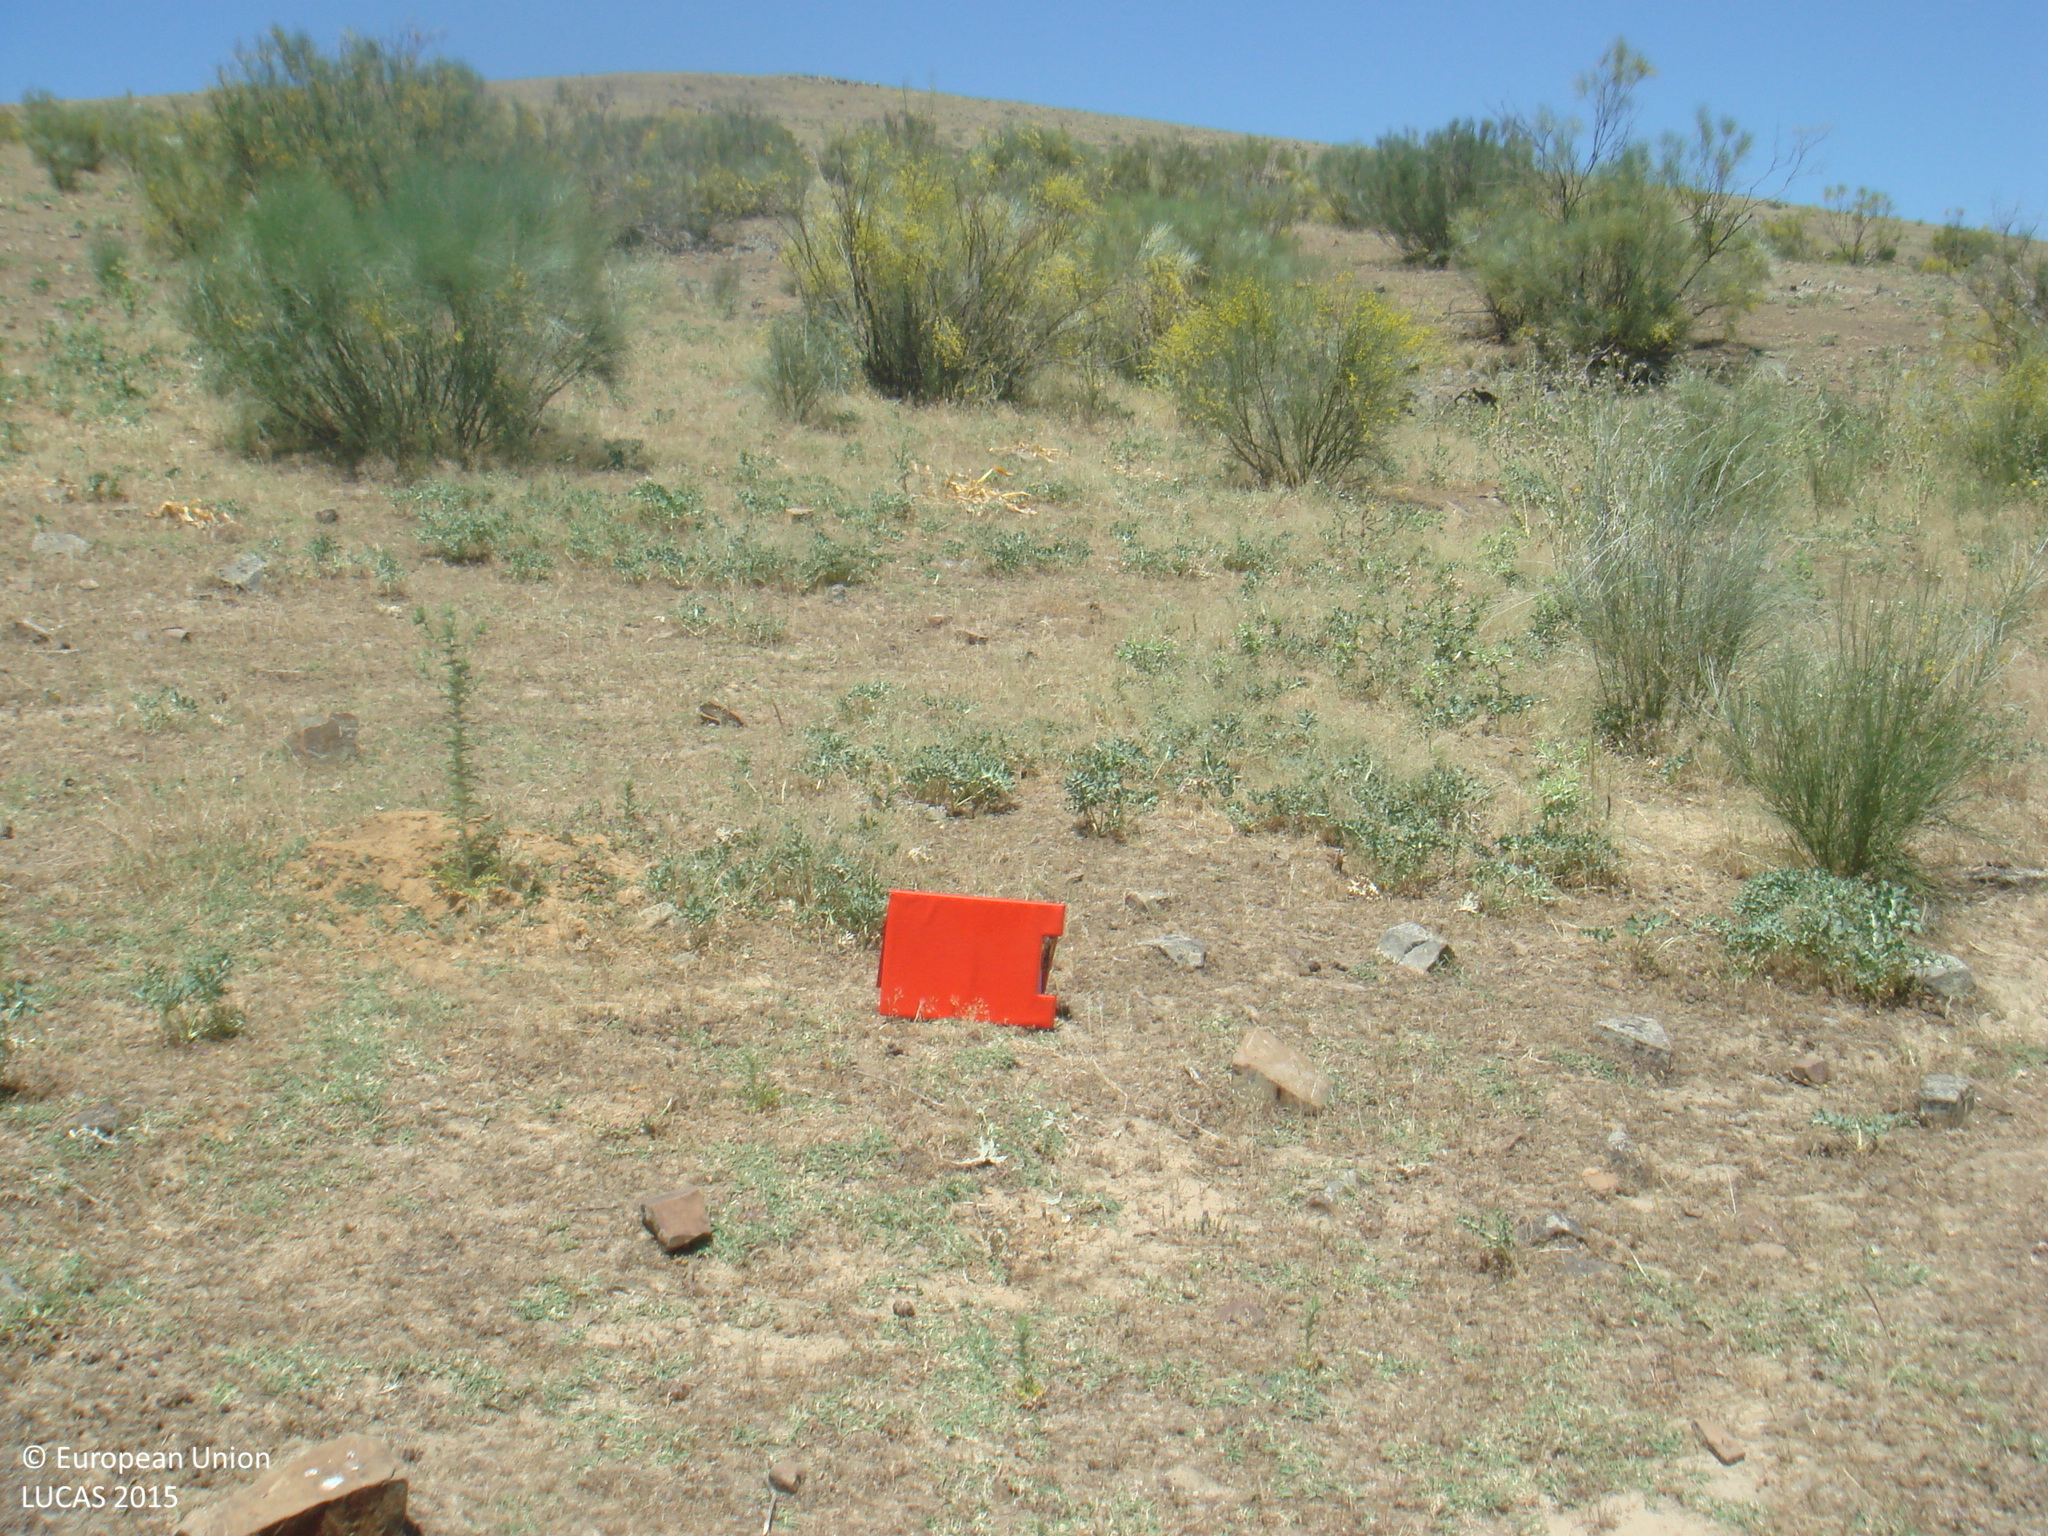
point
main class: Shrubland
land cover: Shrubland without tree cover
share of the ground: 10 - 25 %
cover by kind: herbaceous plants 75 %, shrubs 20 %
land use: Agriculture (excluding fallow land and kitchen gardens)
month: May
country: ES
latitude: 38.7039
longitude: -5.1076
